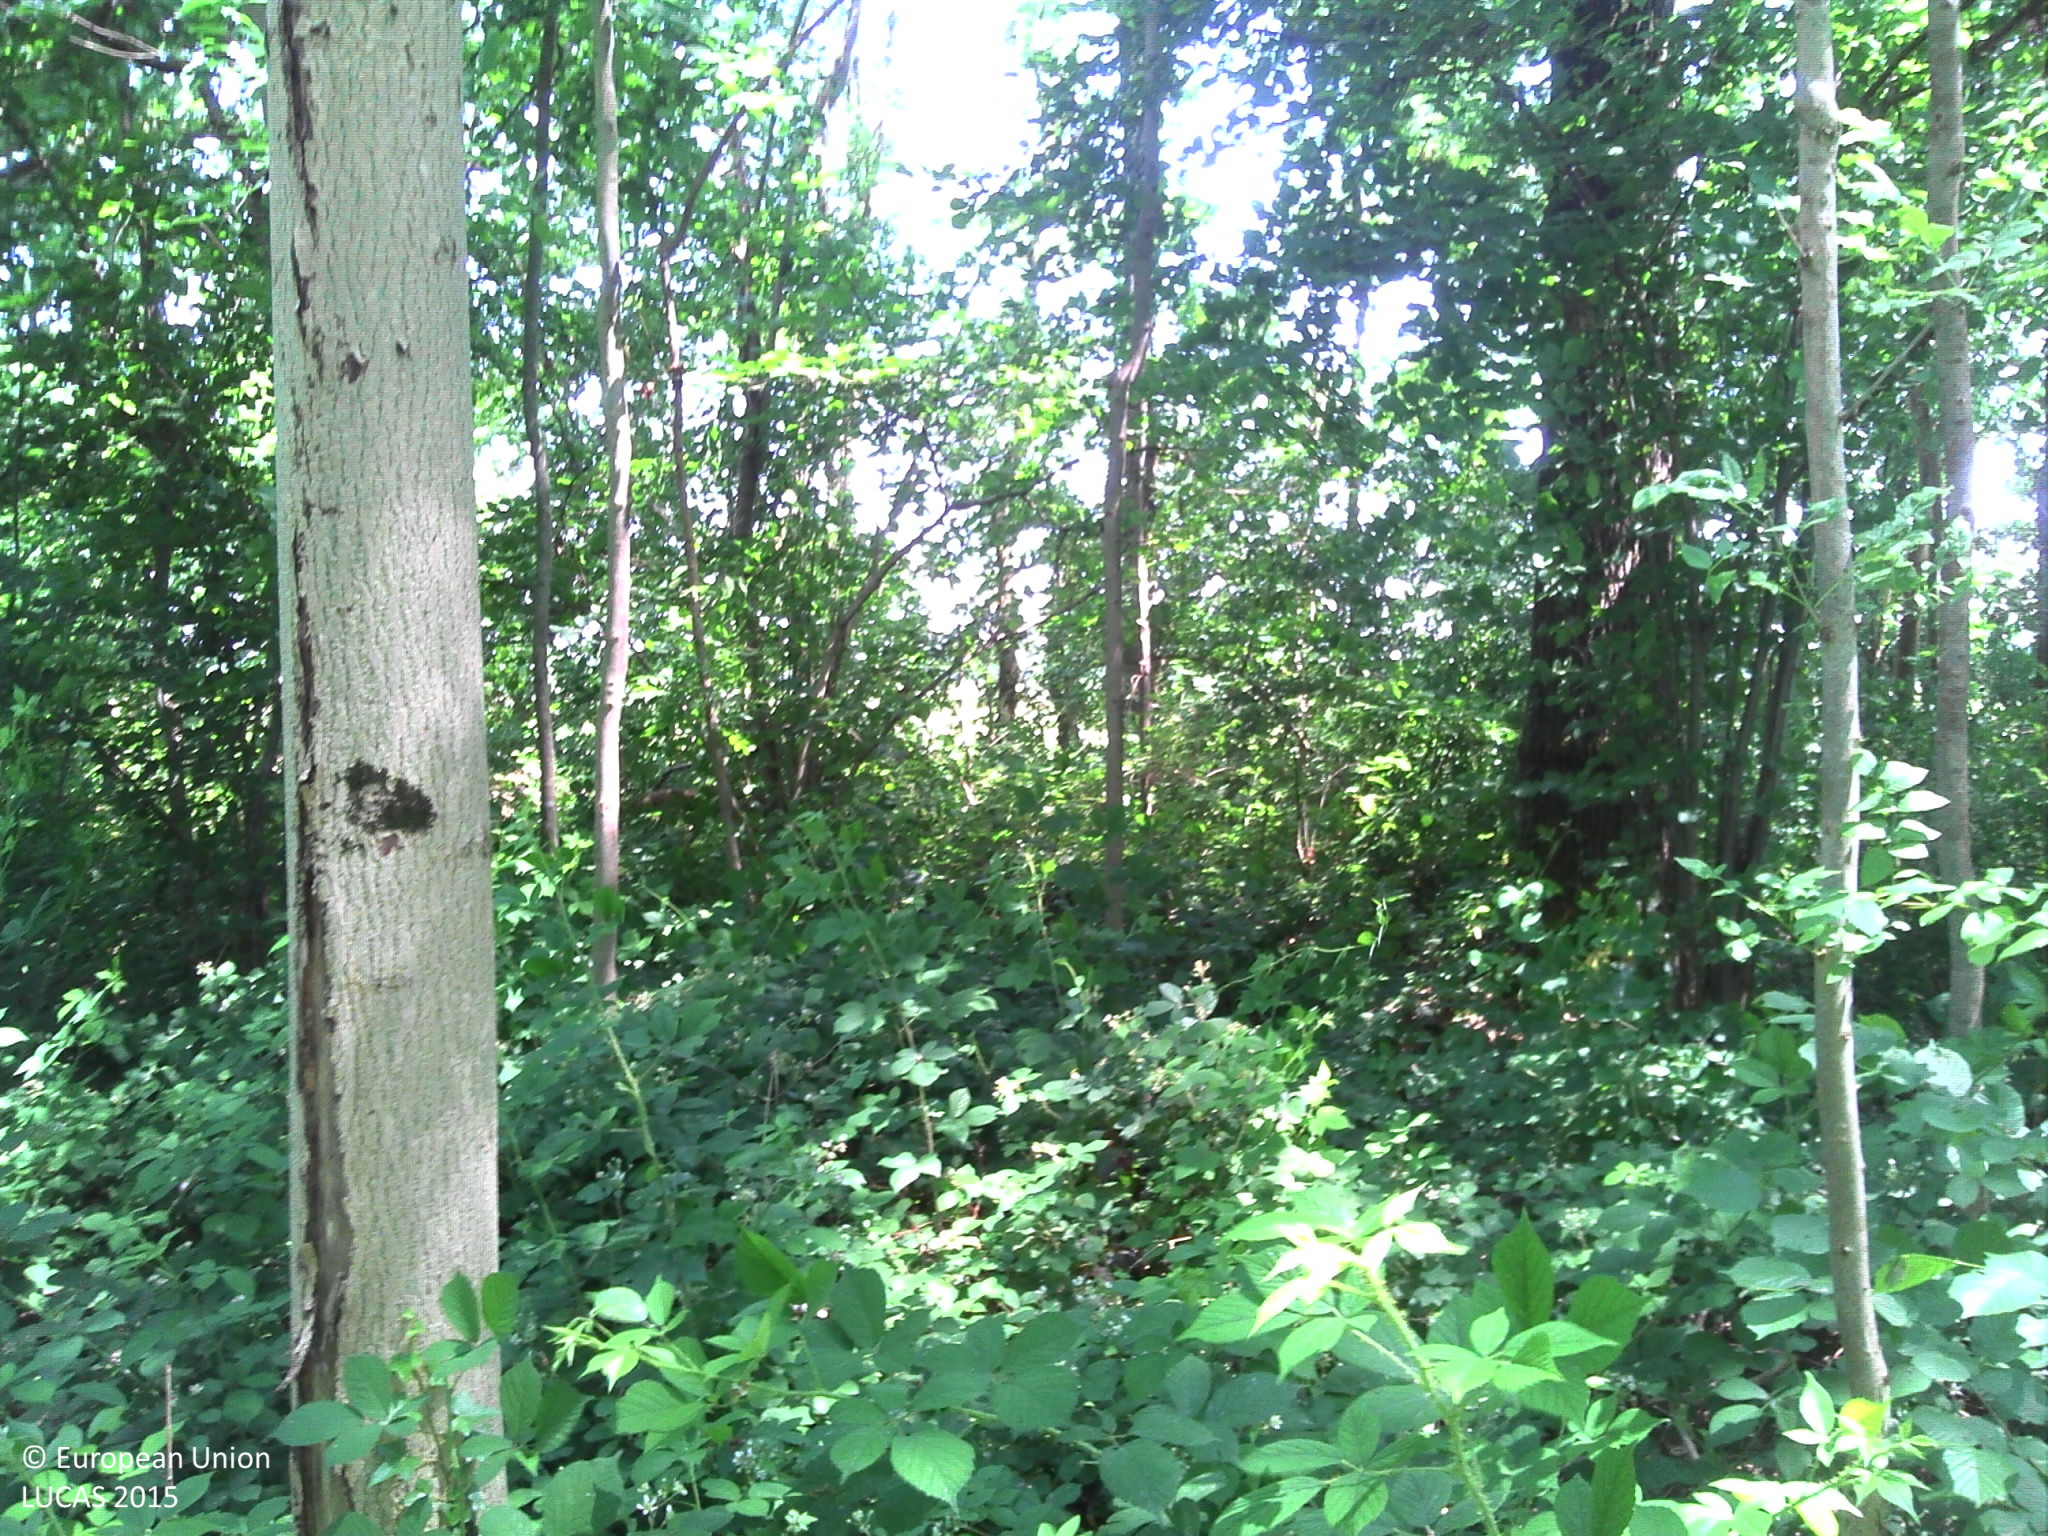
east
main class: Woodland
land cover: Broadleaved woodland
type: mesophytic deciduous forest
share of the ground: > 75 %
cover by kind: broadleaved forest trees 80 %, herbaceous plants 20 %
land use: Forestry
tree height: > 5 m
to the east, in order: Broadleaved woodland; Ditches and canals; Grass margins; Maize; Broadleaved woodland; Ditches and canals; Broadleaved woodland; Grass margins; Maize; Grass margins; Common wheat
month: June
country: FR
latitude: 46.0298
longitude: 4.8740
